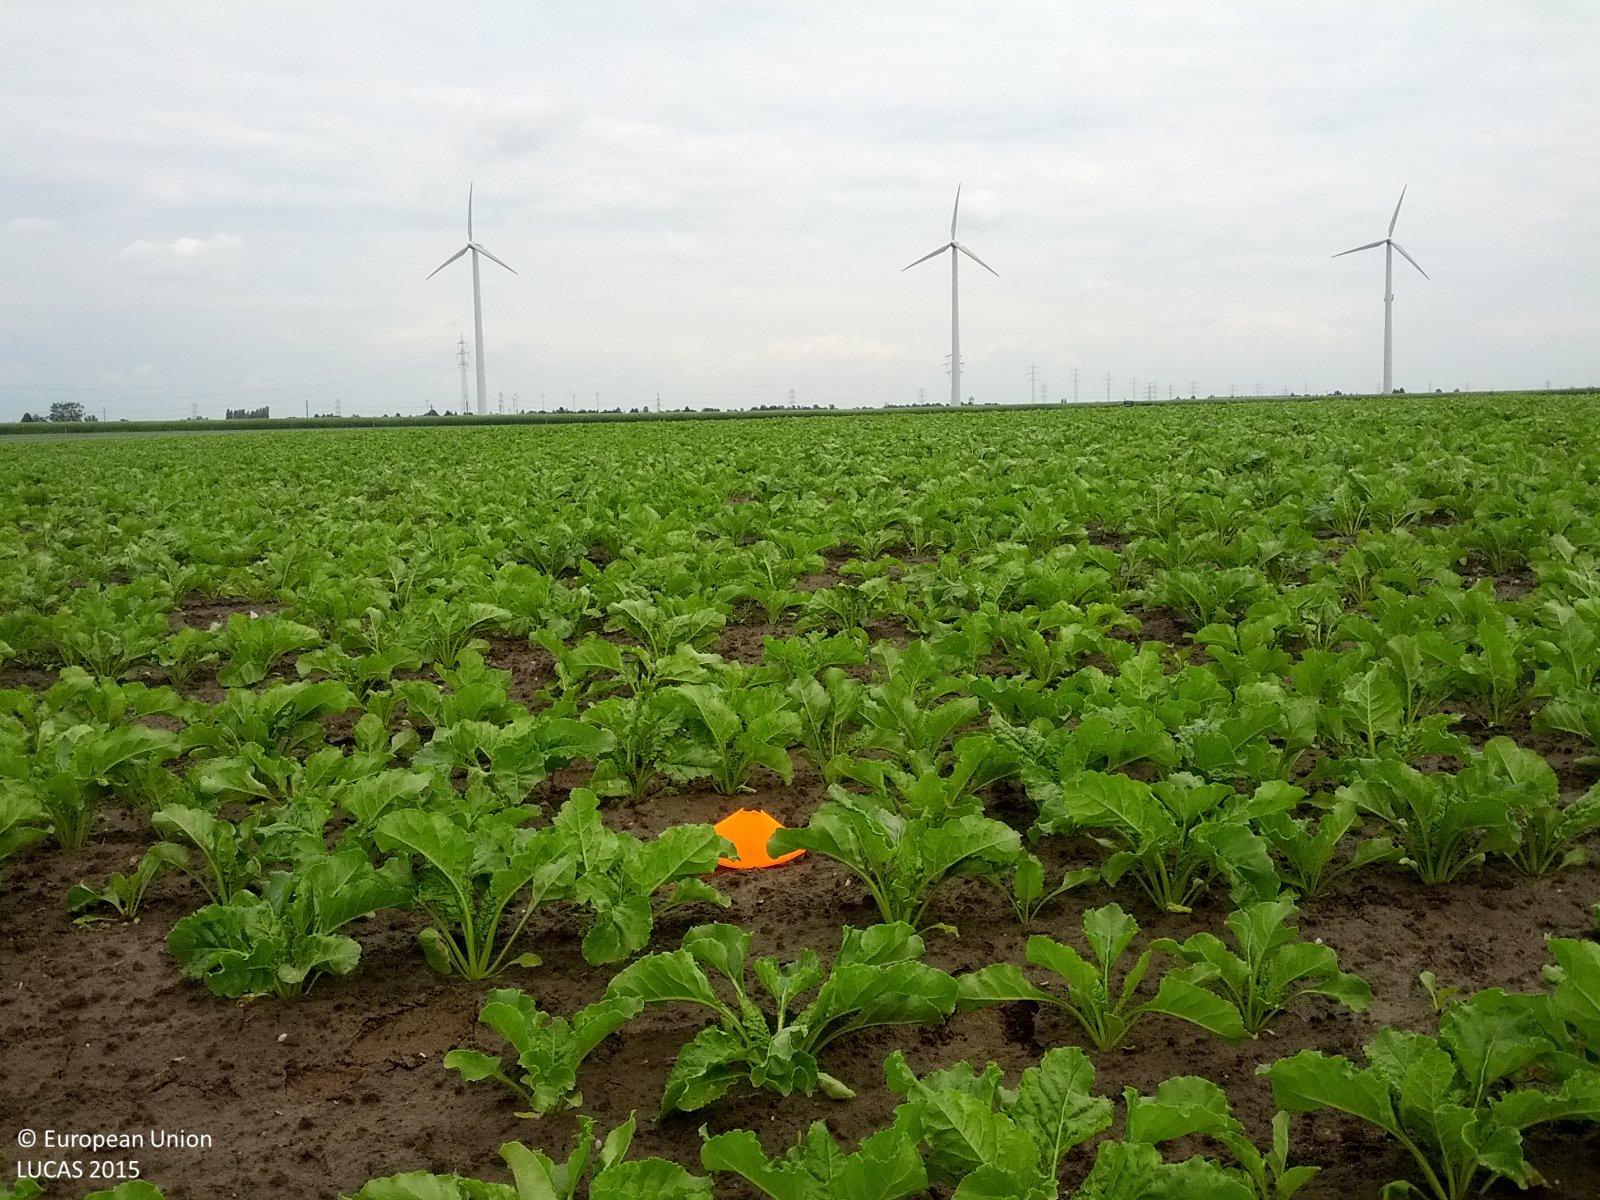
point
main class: Cropland
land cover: Sugar beet
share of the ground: 50 - 75 %
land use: Agriculture (excluding fallow land and kitchen gardens)
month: May
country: AT
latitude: 48.2656
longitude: 16.5125
